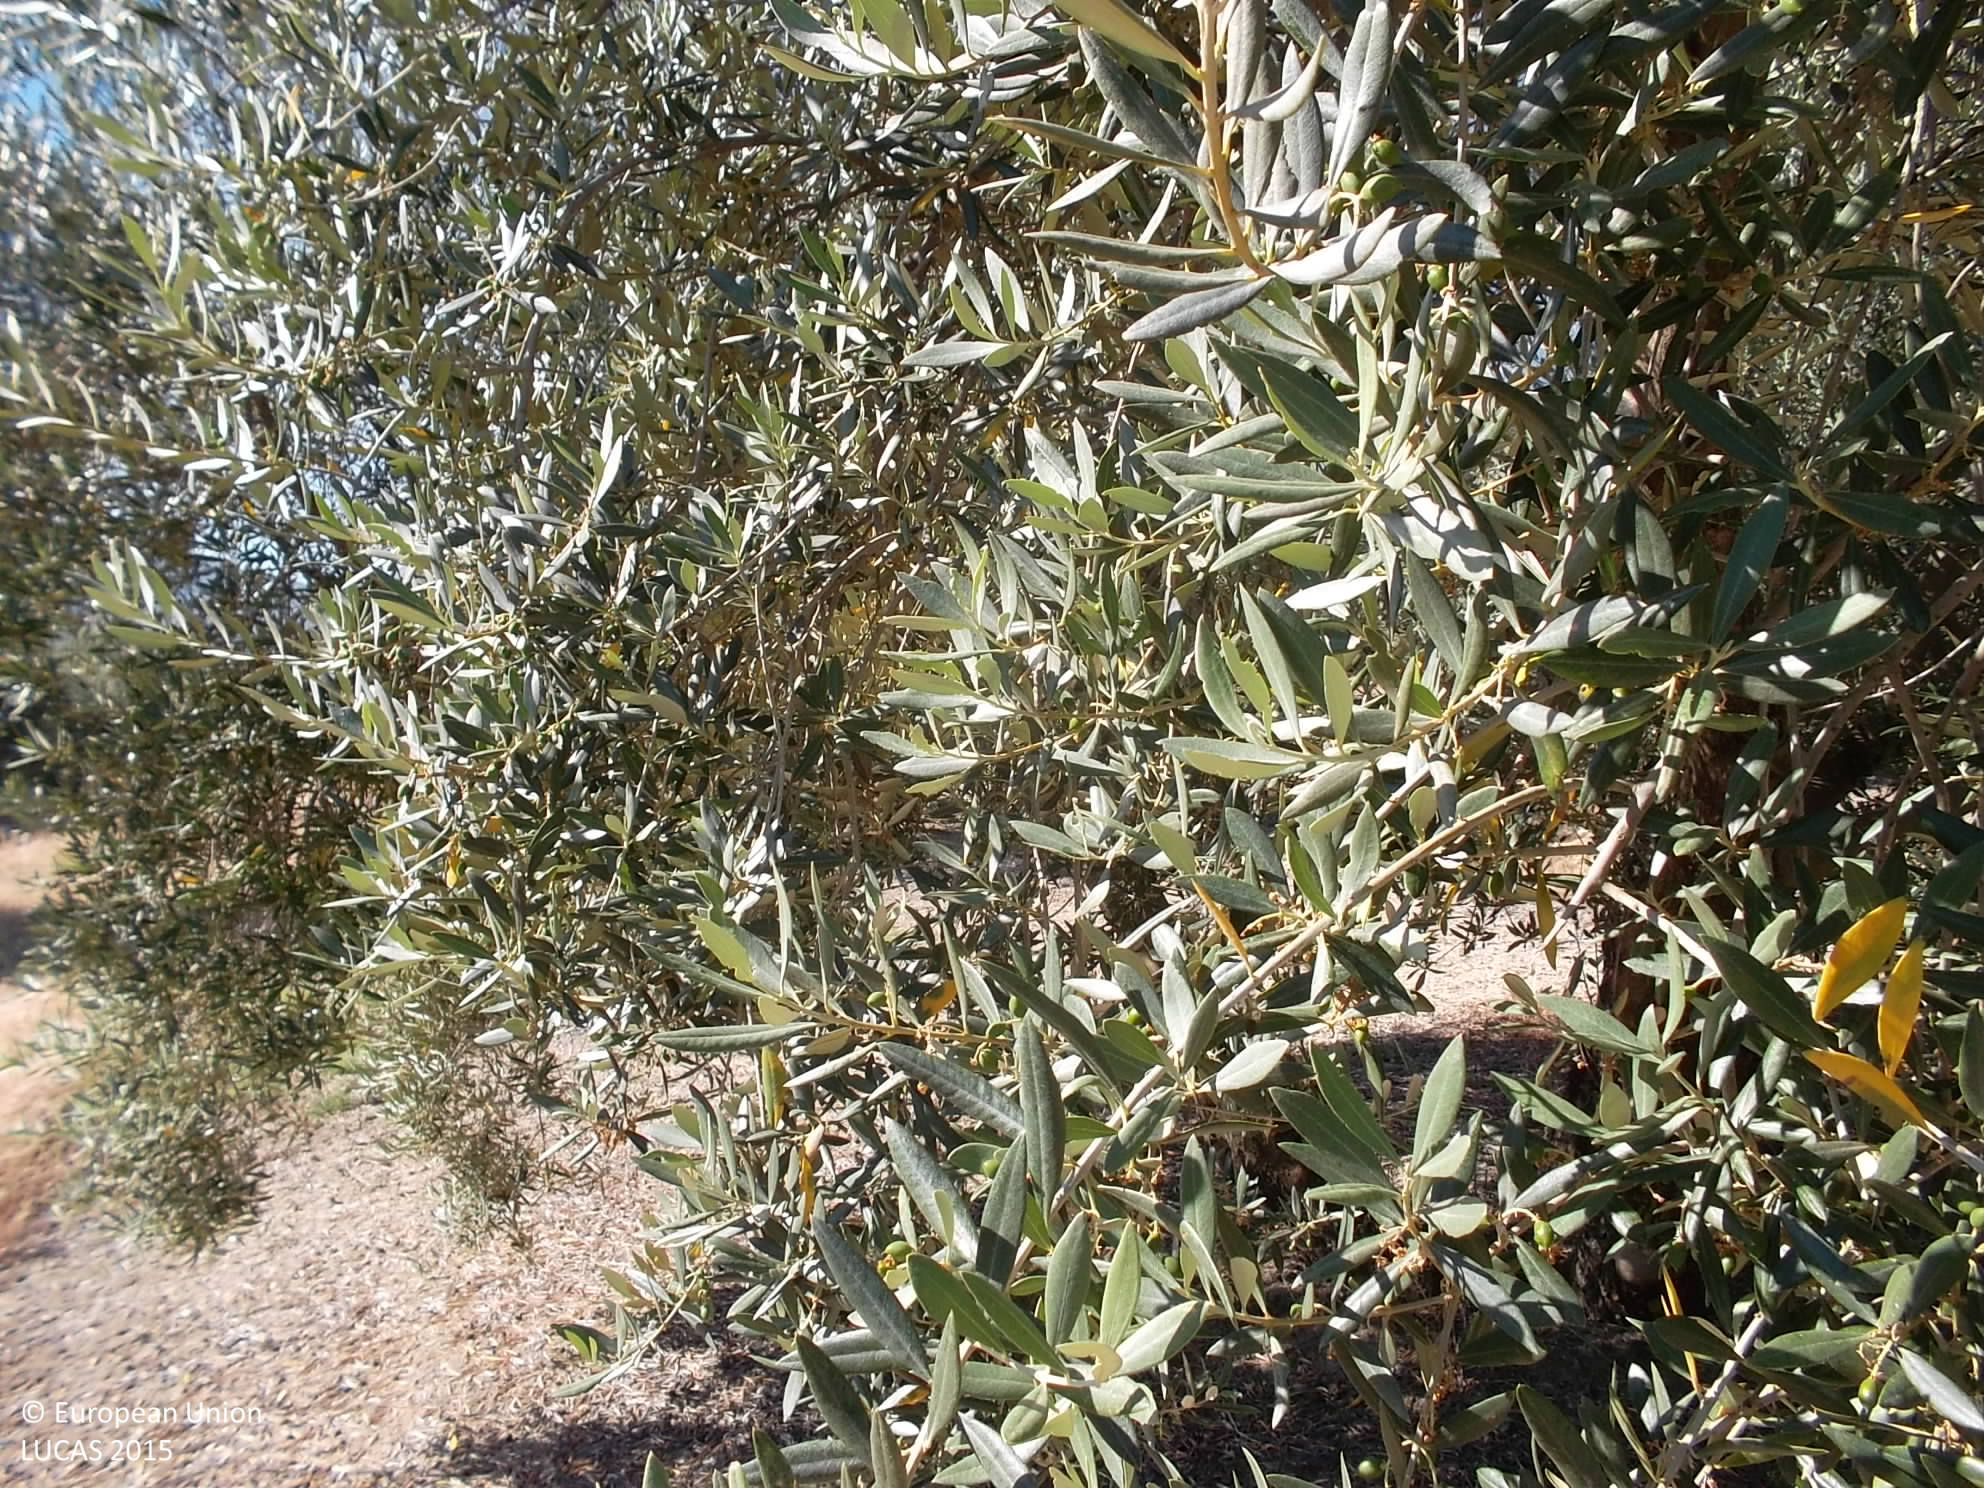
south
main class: Cropland
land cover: Olive groves
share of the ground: 50 - 75 %
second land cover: Other bare soil
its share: > 75 %
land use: Agriculture (excluding fallow land and kitchen gardens)
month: June
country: ES
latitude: 37.9774
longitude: -3.0775
